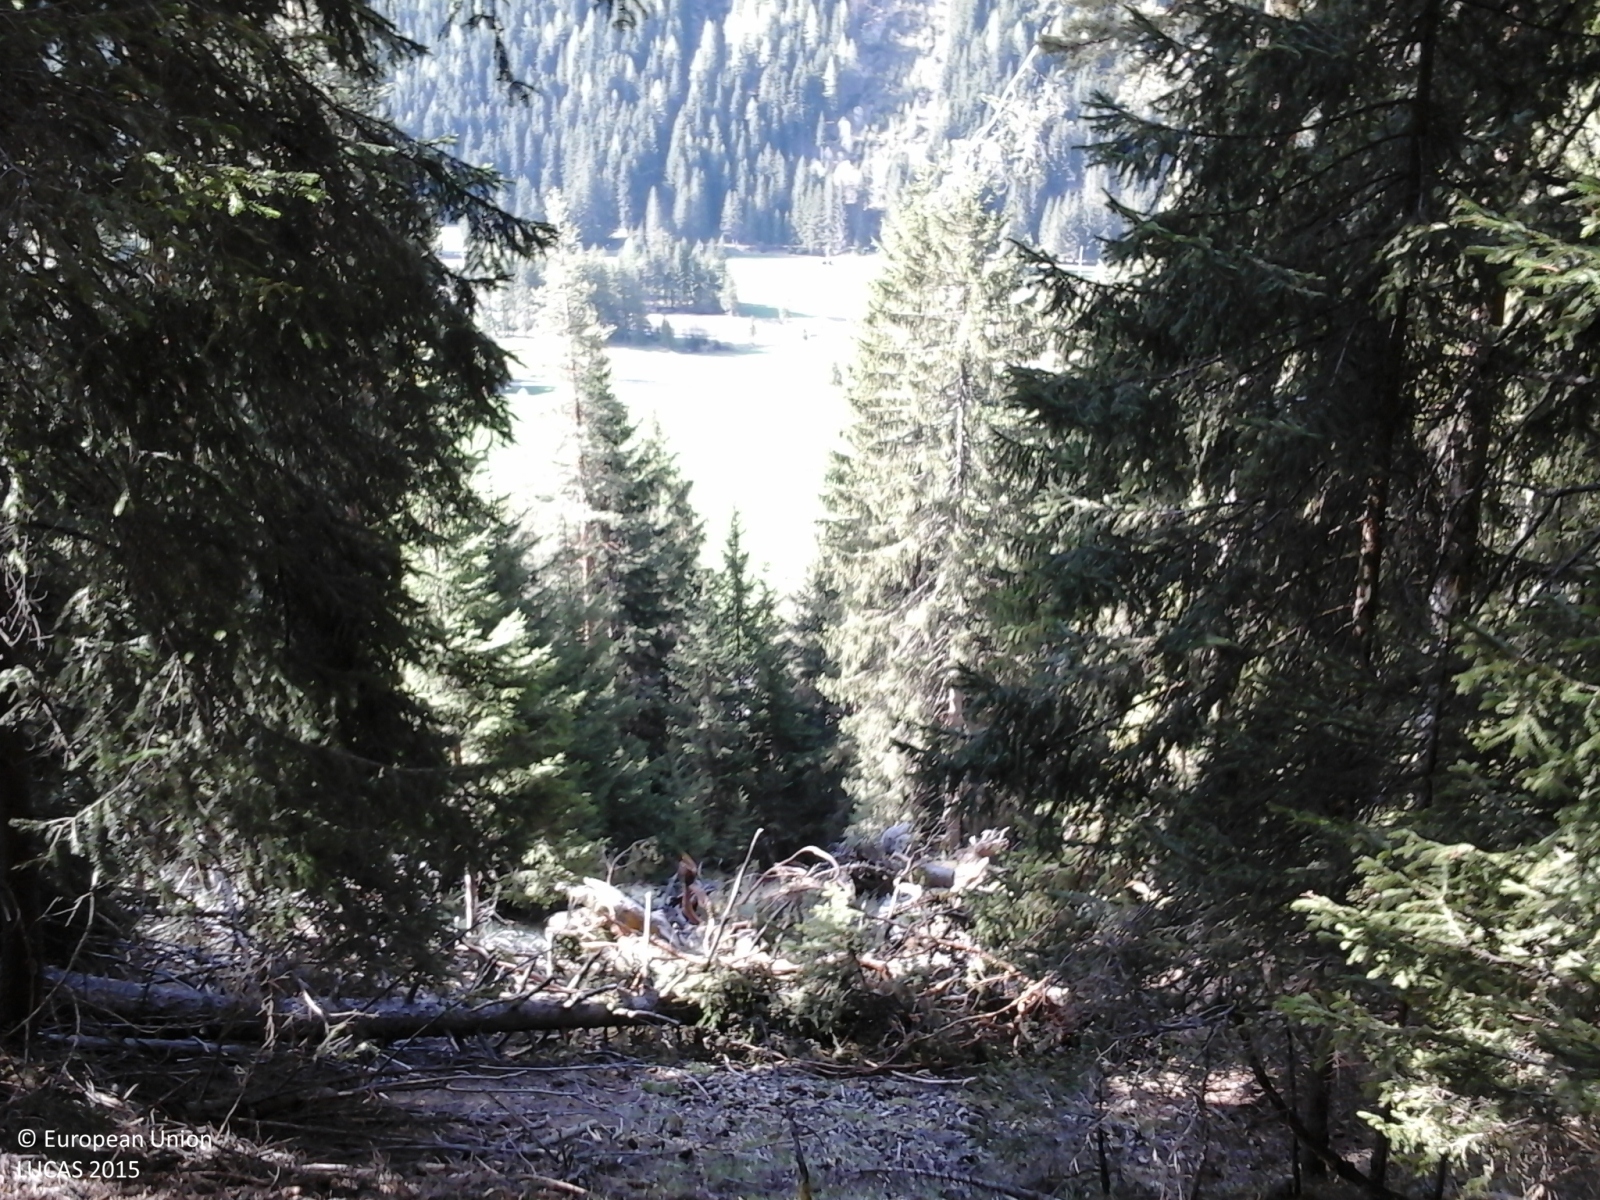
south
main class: Woodland
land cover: Spruce dominated coniferous woodland
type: alpine coniferous forest
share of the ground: > 75 %
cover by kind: coniferous forest trees 85 %, unconsolidated bare surface 10 %, herbaceous plants 5 %
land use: Forestry
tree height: > 5 m
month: May
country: IT
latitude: 46.4809
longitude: 11.7564
